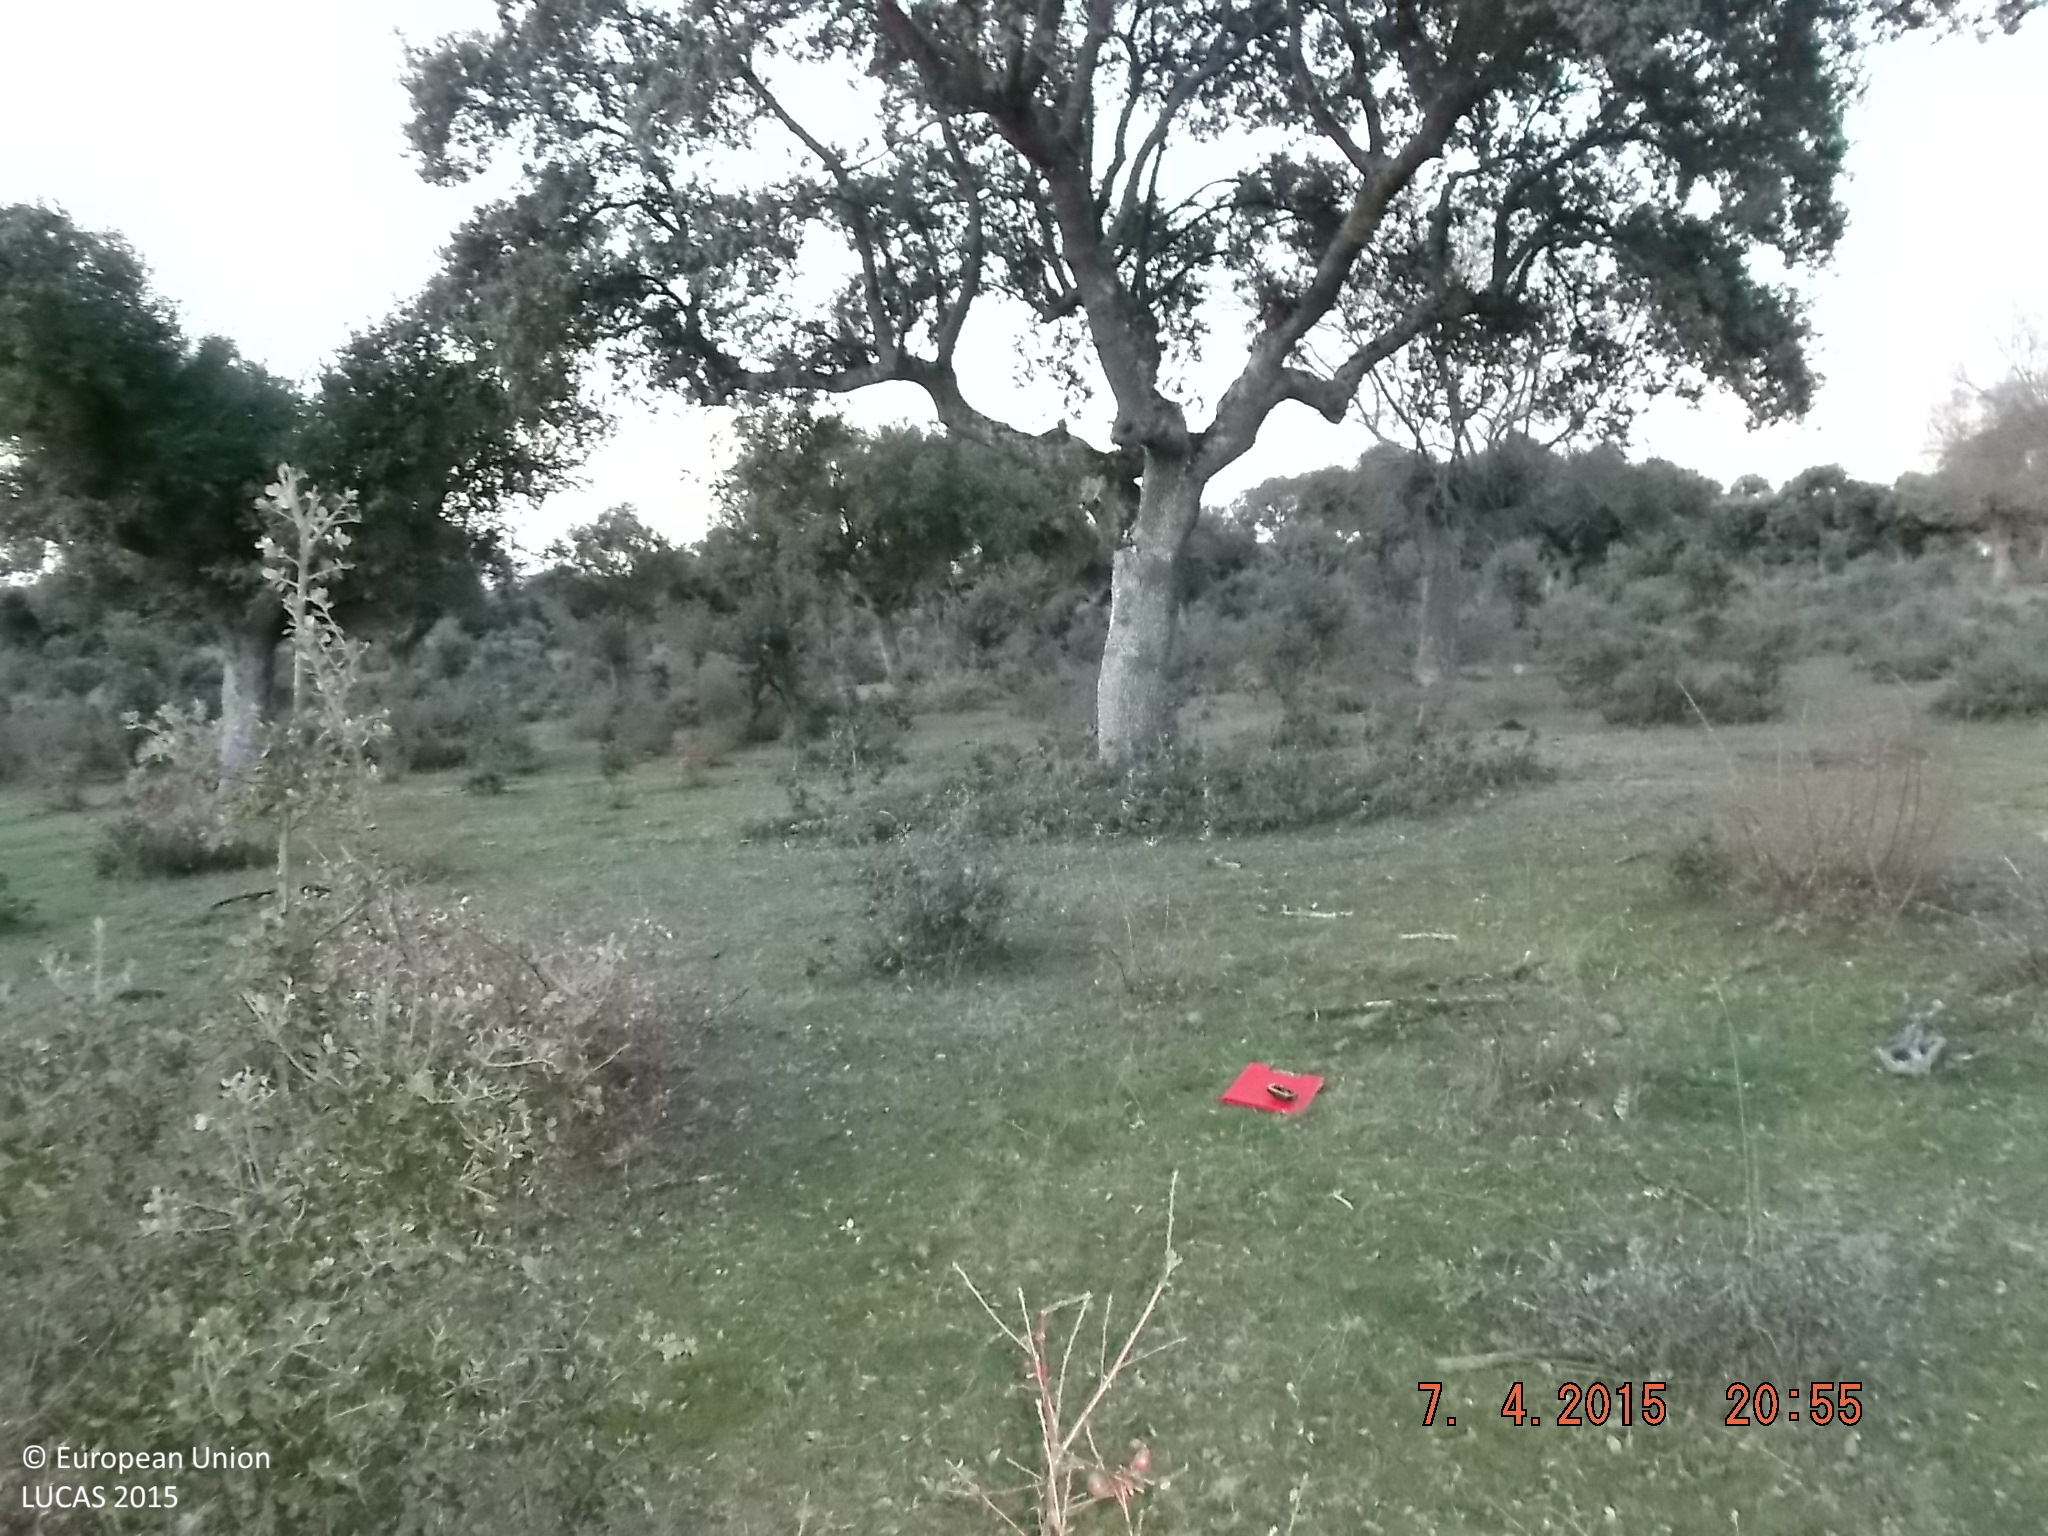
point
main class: Woodland
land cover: Broadleaved woodland
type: broadleaved evergreen forest
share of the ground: 25 - 50 %
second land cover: Shrubland without tree cover
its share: 50 - 75 %
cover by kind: shrubs 50 %, broadleaved forest trees 40 %, herbaceous plants 10 %
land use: Forestry
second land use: Agriculture (excluding fallow land and kitchen gardens)
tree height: < 5 m
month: April
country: ES
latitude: 40.8253
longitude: -5.8611
